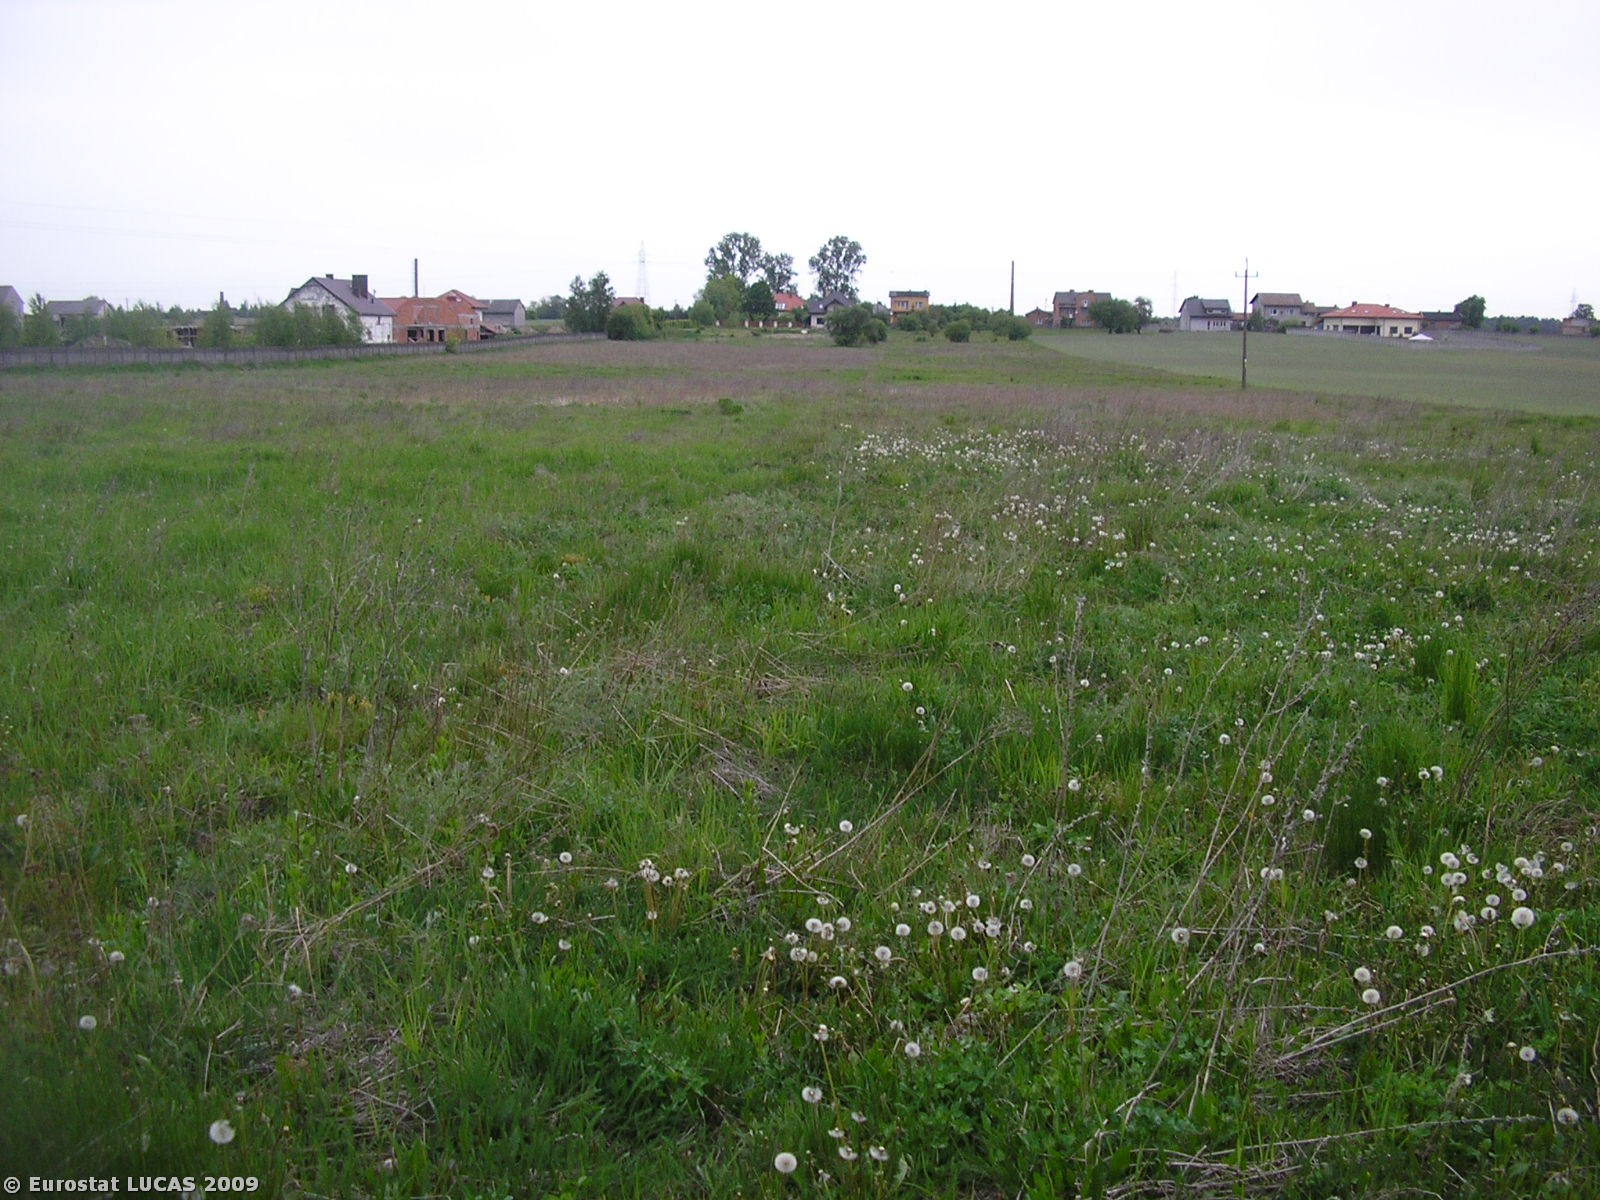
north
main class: Grassland
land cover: Grassland without tree/shrub cover
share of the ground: > 75 %
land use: Agriculture (excluding fallow land and kitchen gardens)
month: May
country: PL
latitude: 51.5047
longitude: 19.9589
